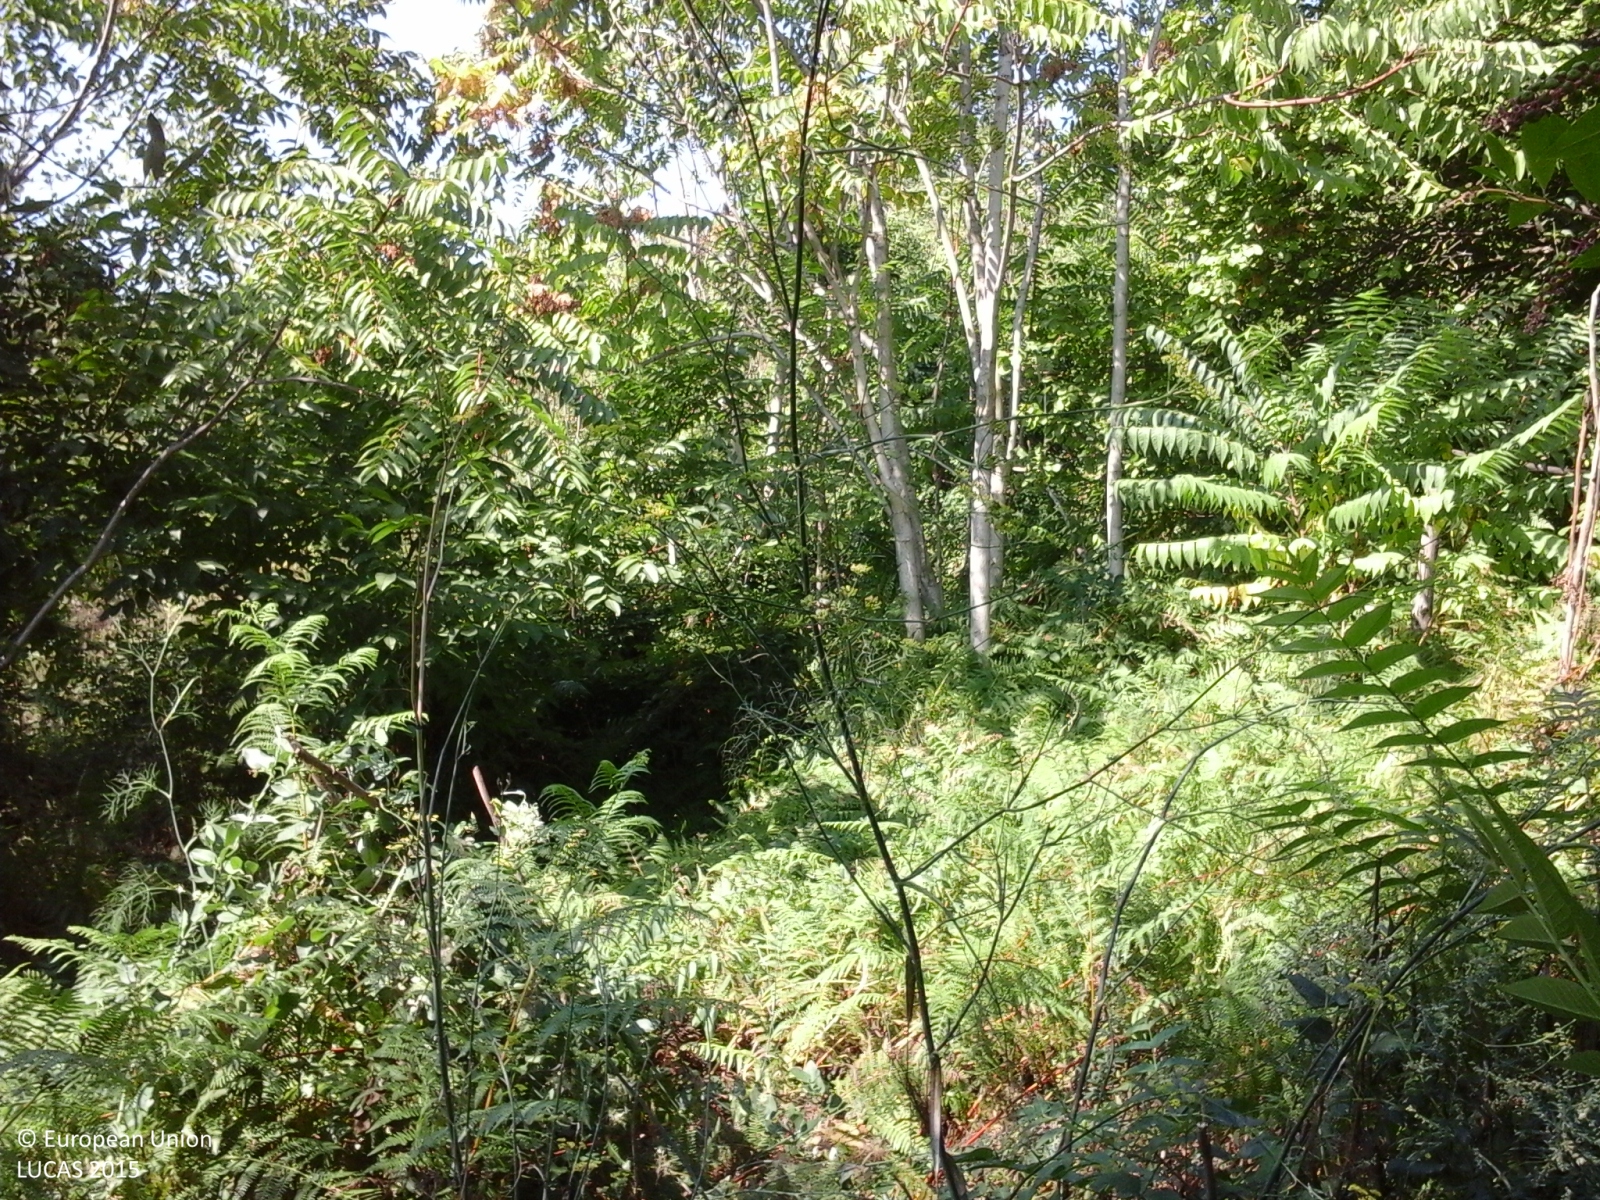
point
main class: Woodland
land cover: Broadleaved woodland
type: exotic forest
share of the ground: > 75 %
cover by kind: broadleaved forest trees 100 %
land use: Semi-natural and natural areas not in use
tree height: > 5 m
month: August
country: IT
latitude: 40.7536
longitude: 14.6829
